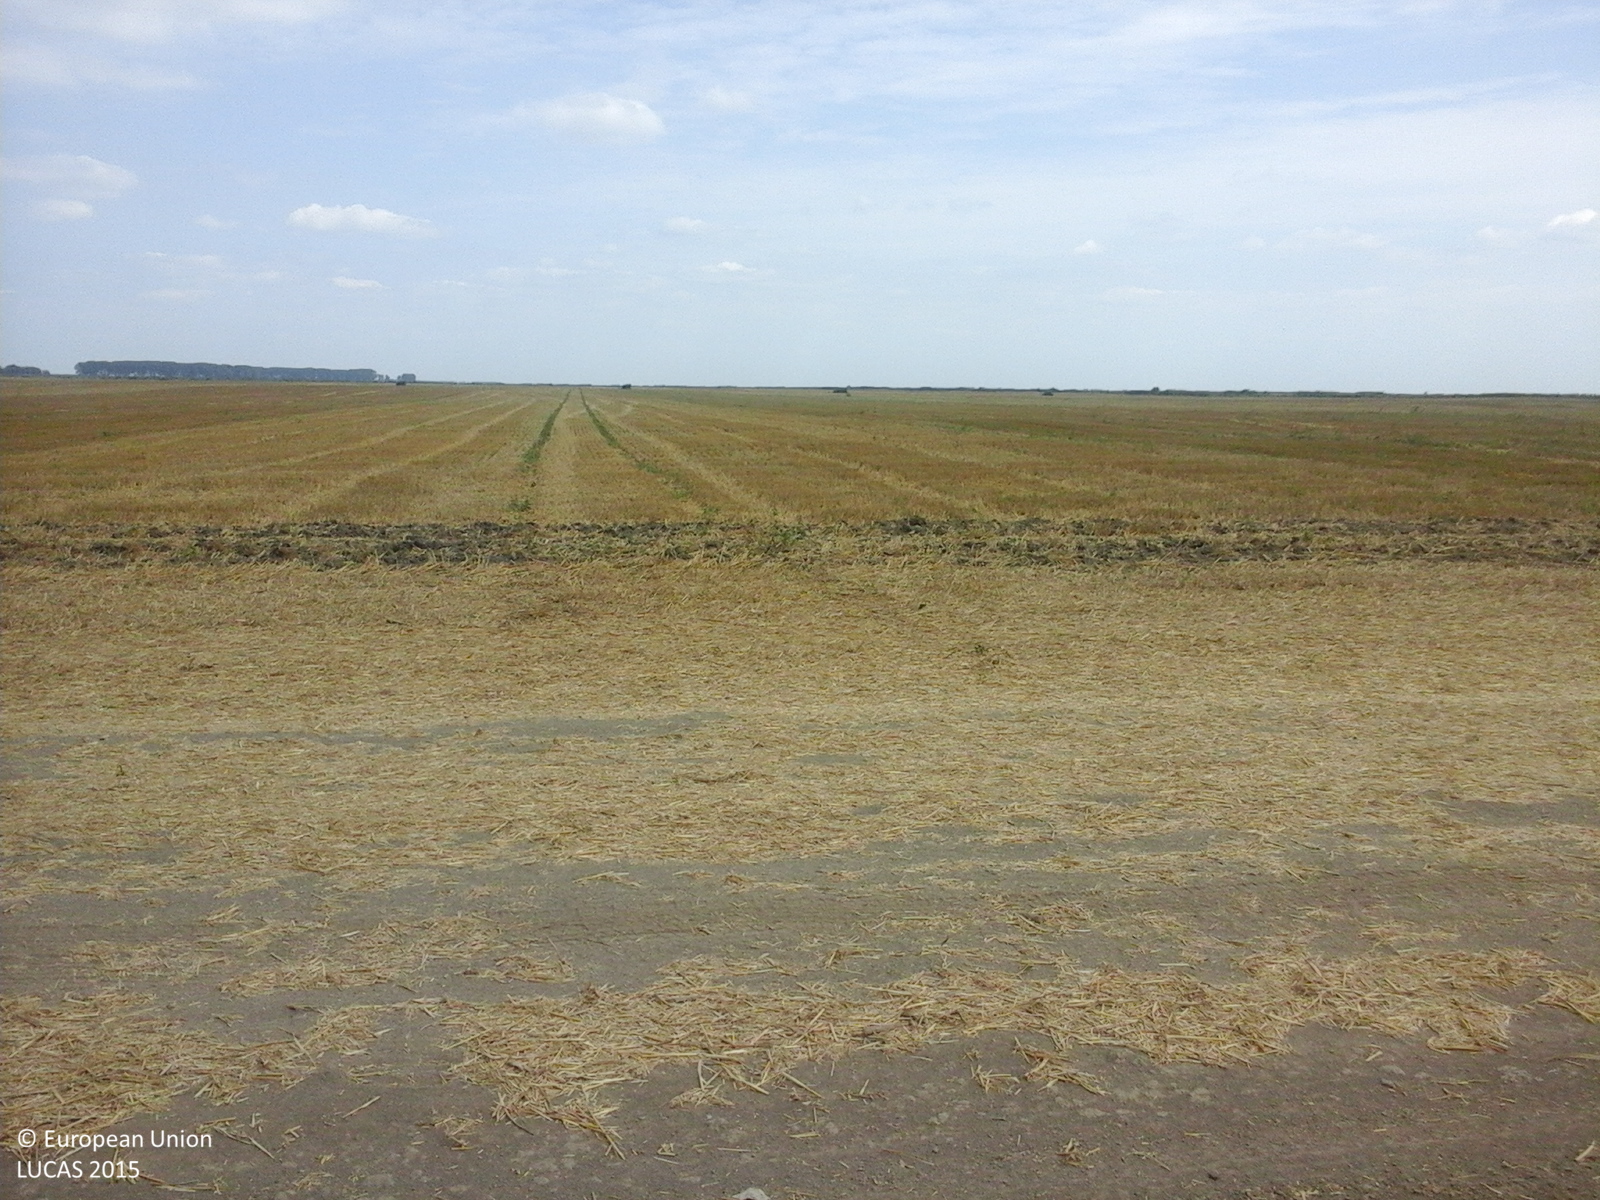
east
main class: Cropland
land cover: Sunflower
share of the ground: 50 - 75 %
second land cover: Spontaneously vegetated surfaces
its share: 25 - 50 %
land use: Agriculture (excluding fallow land and kitchen gardens)
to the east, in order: Sunflower; Spontaneously vegetated surfaces
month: August
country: RO
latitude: 45.3126
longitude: 29.0944
